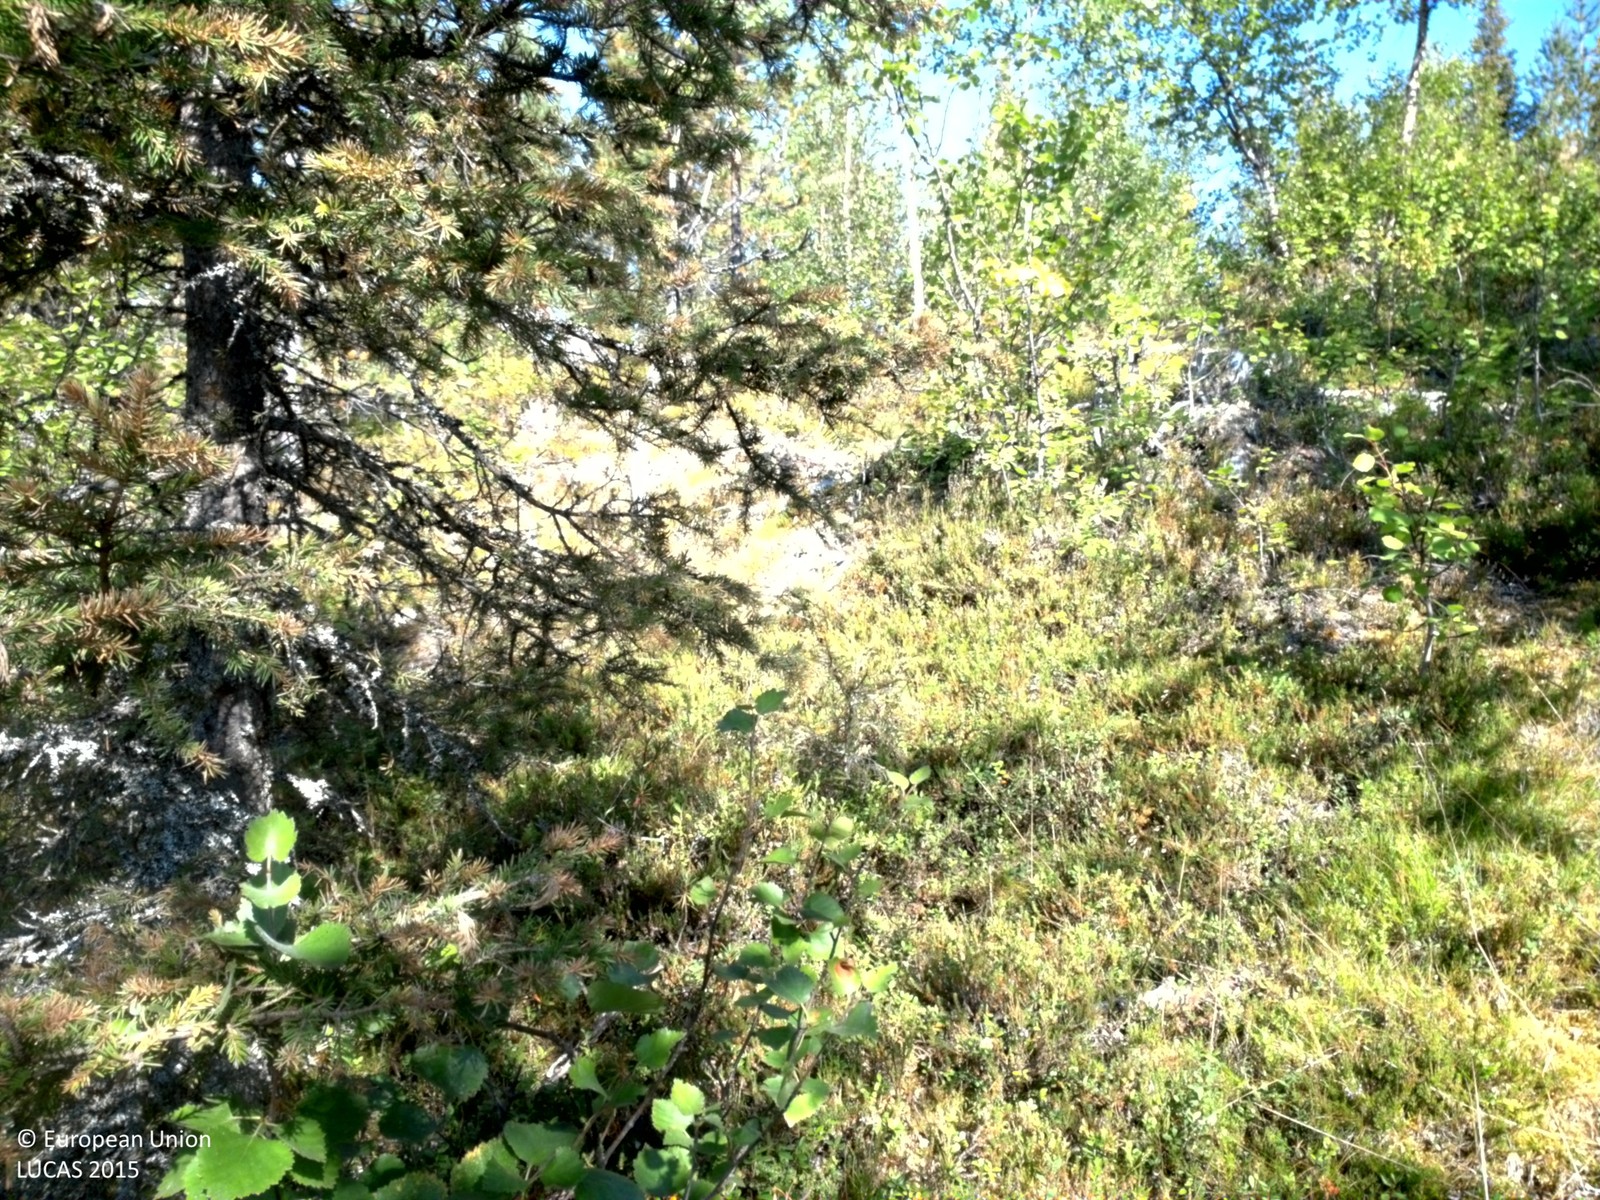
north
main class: Woodland
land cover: Spruce dominated mixed woodland
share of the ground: 25 - 50 %
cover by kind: shrubs 60 %, coniferous forest trees 20 %, broadleaved forest trees 10 %, lichens and mosses 10 %
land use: Forestry
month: August
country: SE
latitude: 66.6949
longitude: 20.8510
